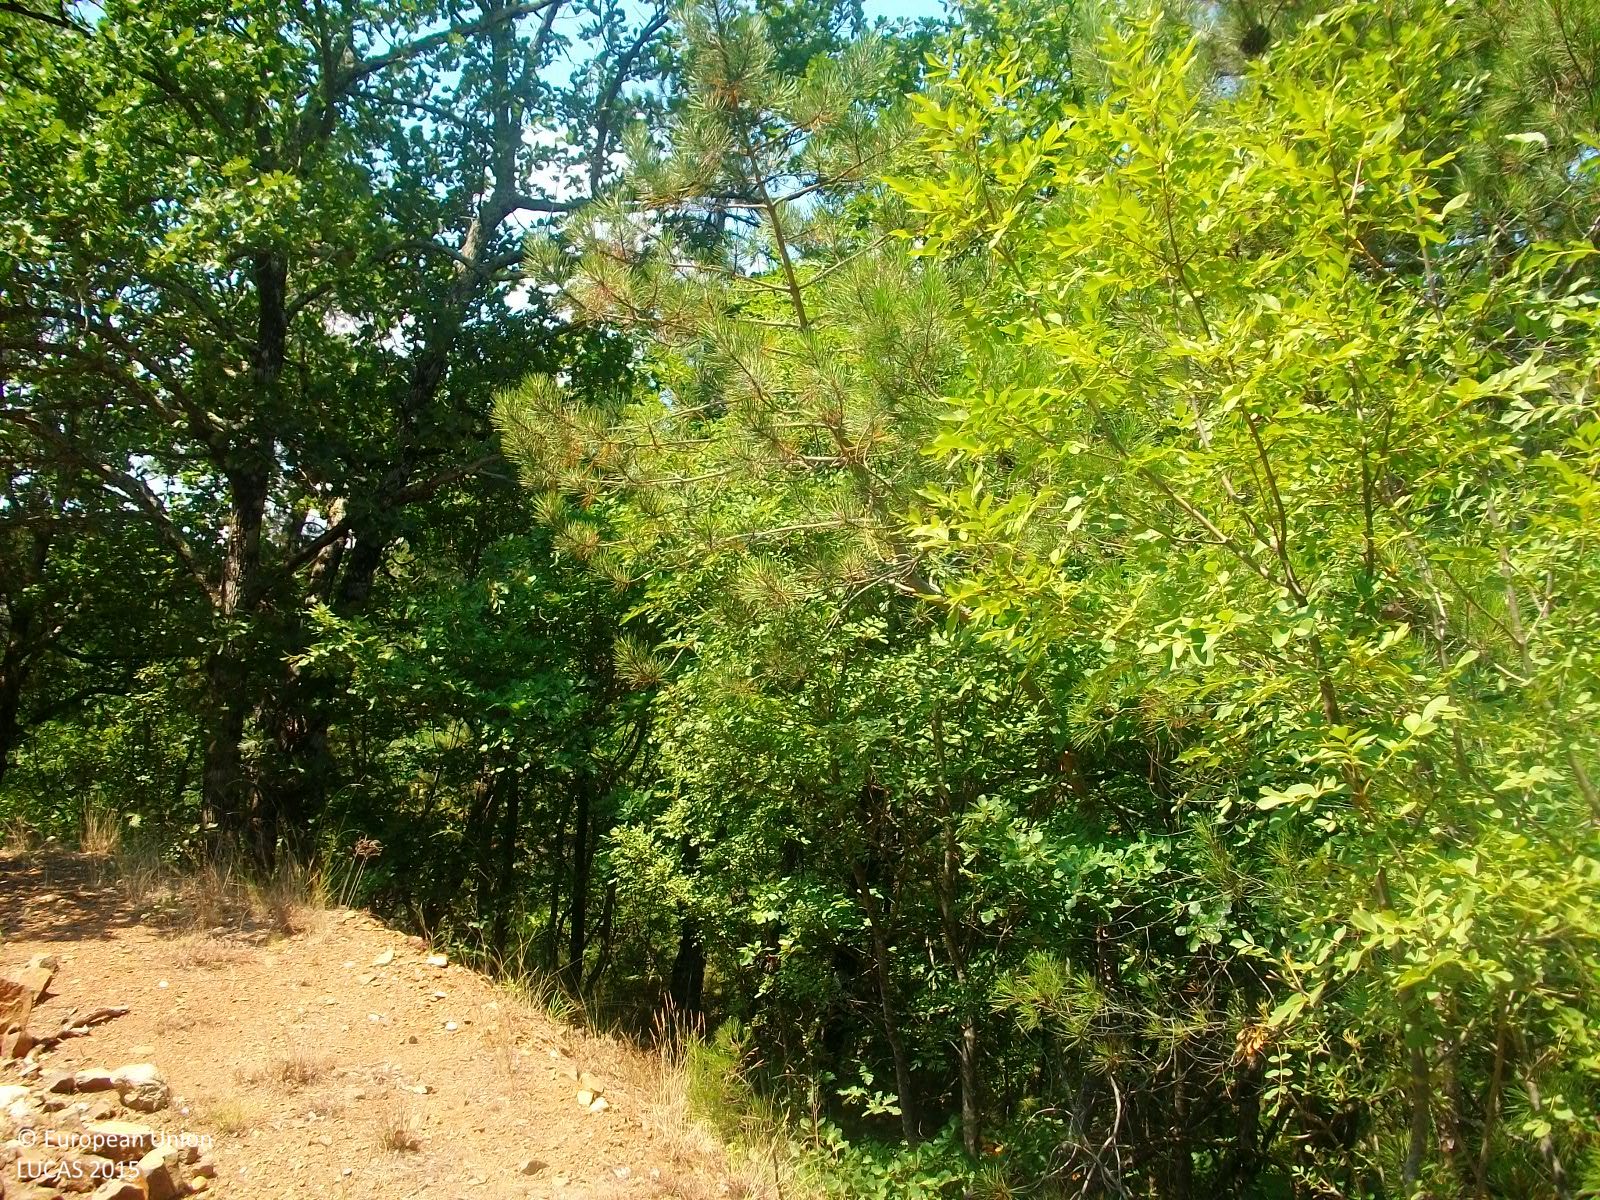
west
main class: Woodland
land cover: Pine dominated mixed woodland
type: coniferous forest of the mediterranean region
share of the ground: > 75 %
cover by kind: coniferous forest trees 50 %, broadleaved forest trees 40 %, shrubs 10 %
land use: Forestry
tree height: > 5 m
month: July
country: GR
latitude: 41.1436
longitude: 26.1626
